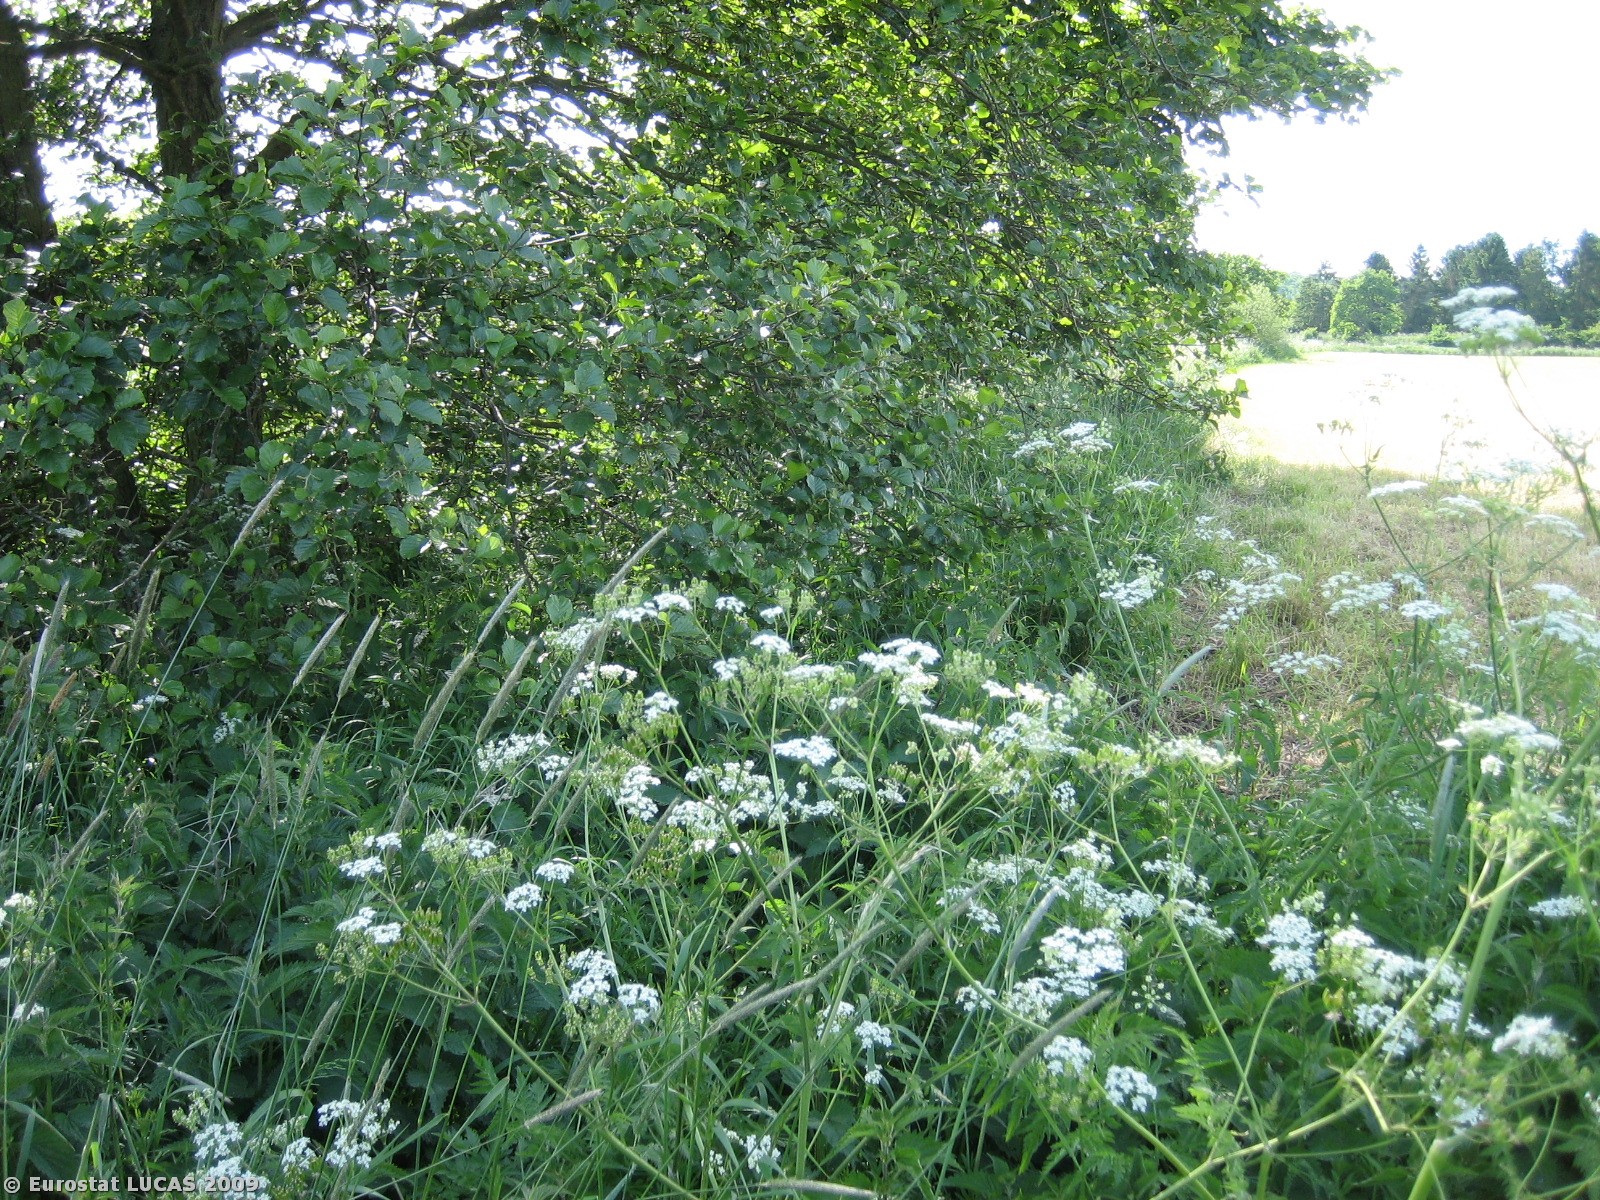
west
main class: Grassland
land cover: Grassland without tree/shrub cover
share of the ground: > 75 %
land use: Unused
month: June
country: DK
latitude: 56.1697
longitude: 9.8552
